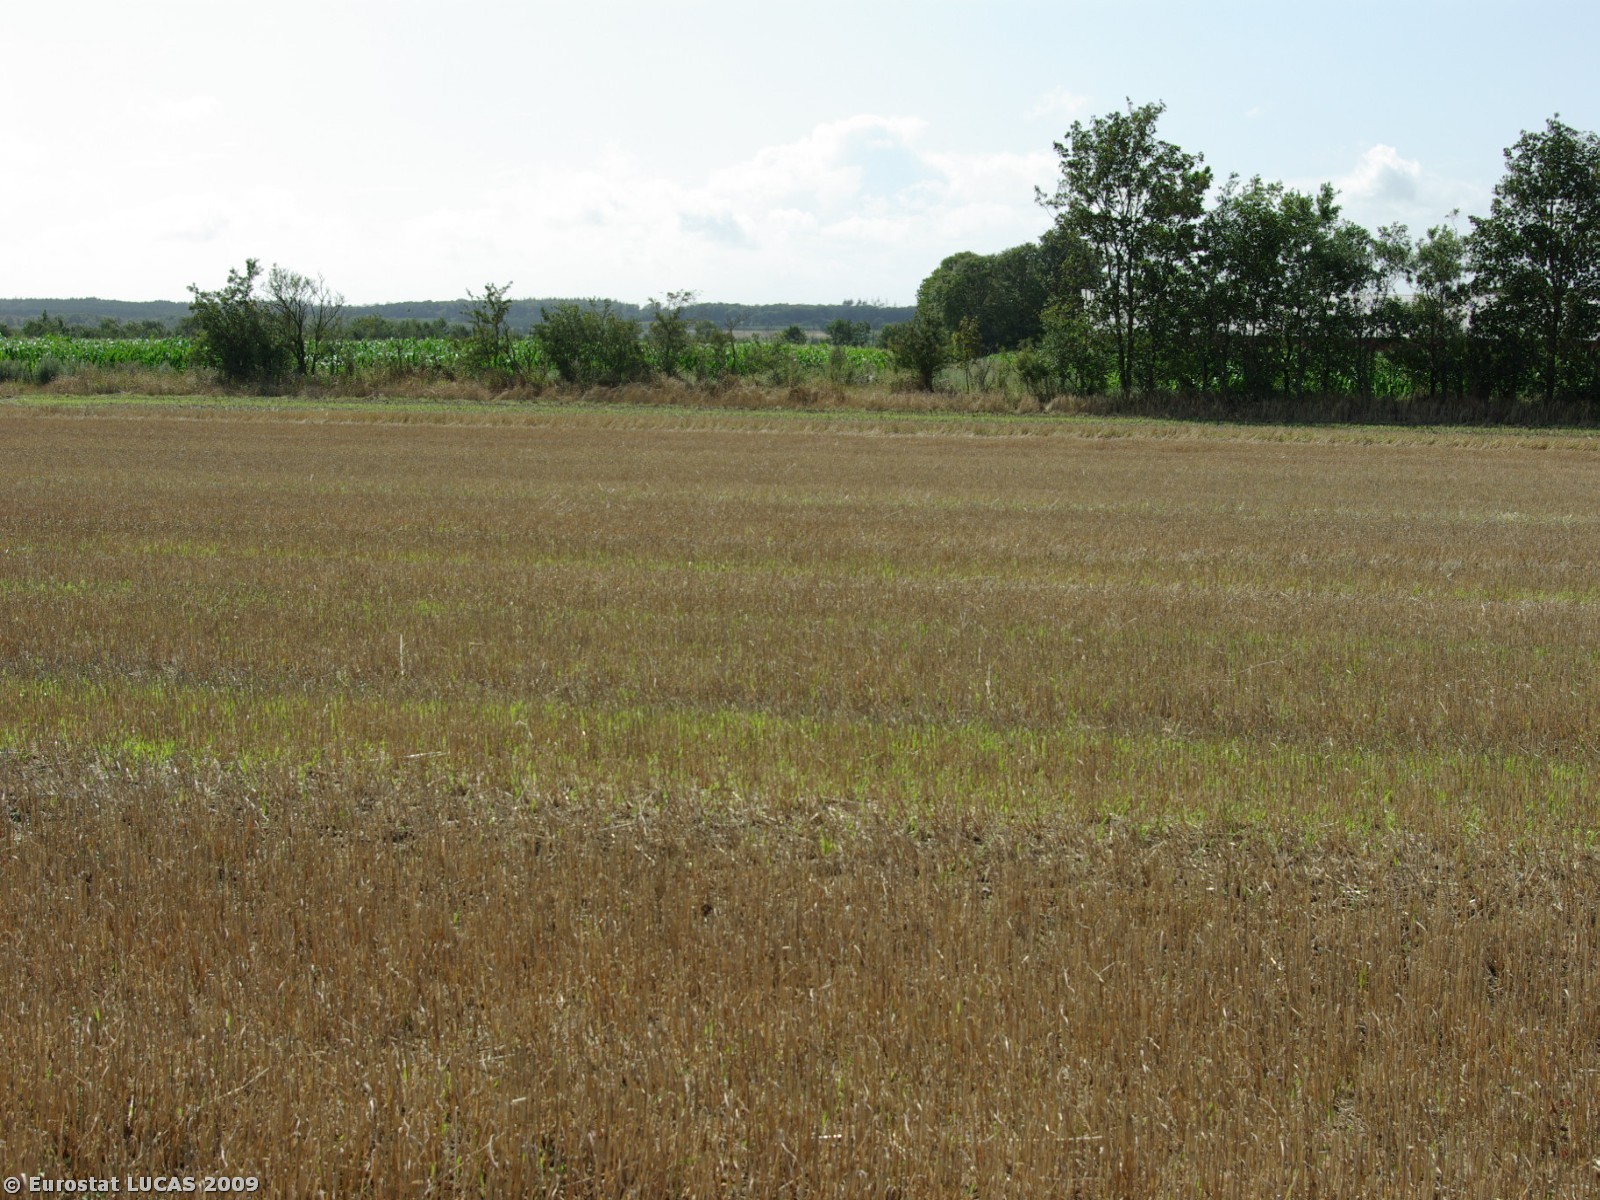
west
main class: Cropland
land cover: Barley
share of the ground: < 10 %
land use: Agriculture (excluding fallow land and kitchen gardens)
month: July
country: DK
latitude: 55.1953
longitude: 9.0111
